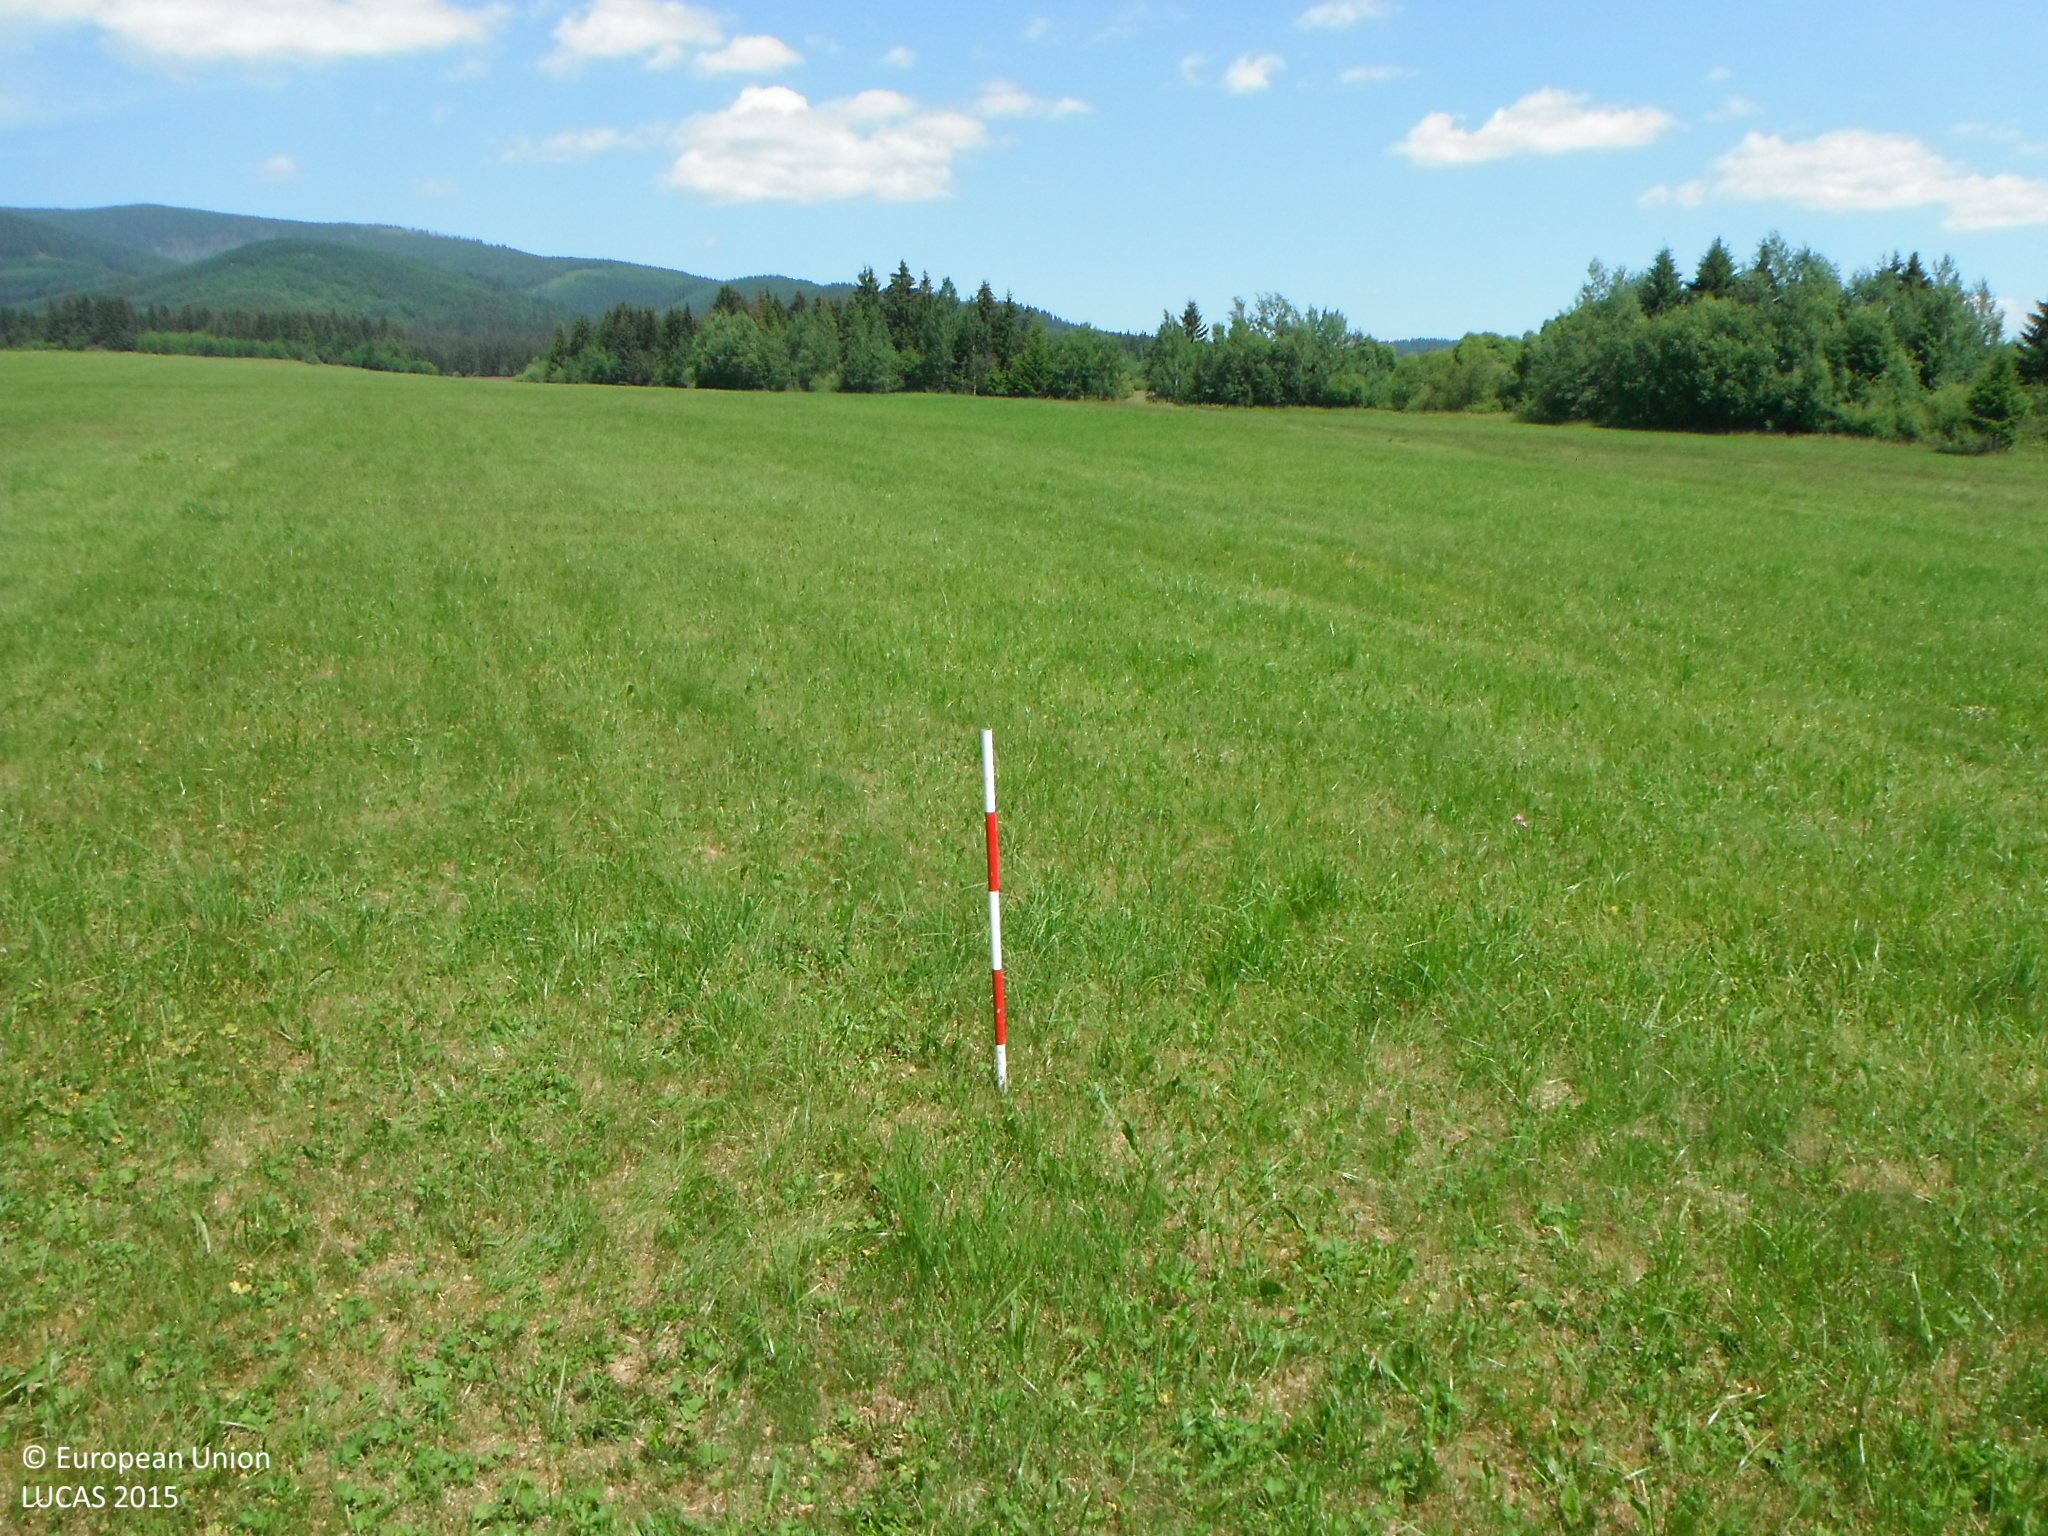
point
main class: Grassland
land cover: Grassland without tree/shrub cover
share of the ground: > 75 %
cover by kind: herbaceous plants 100 %
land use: Agriculture (excluding fallow land and kitchen gardens)
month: July
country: SK
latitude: 49.4742
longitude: 19.3407
